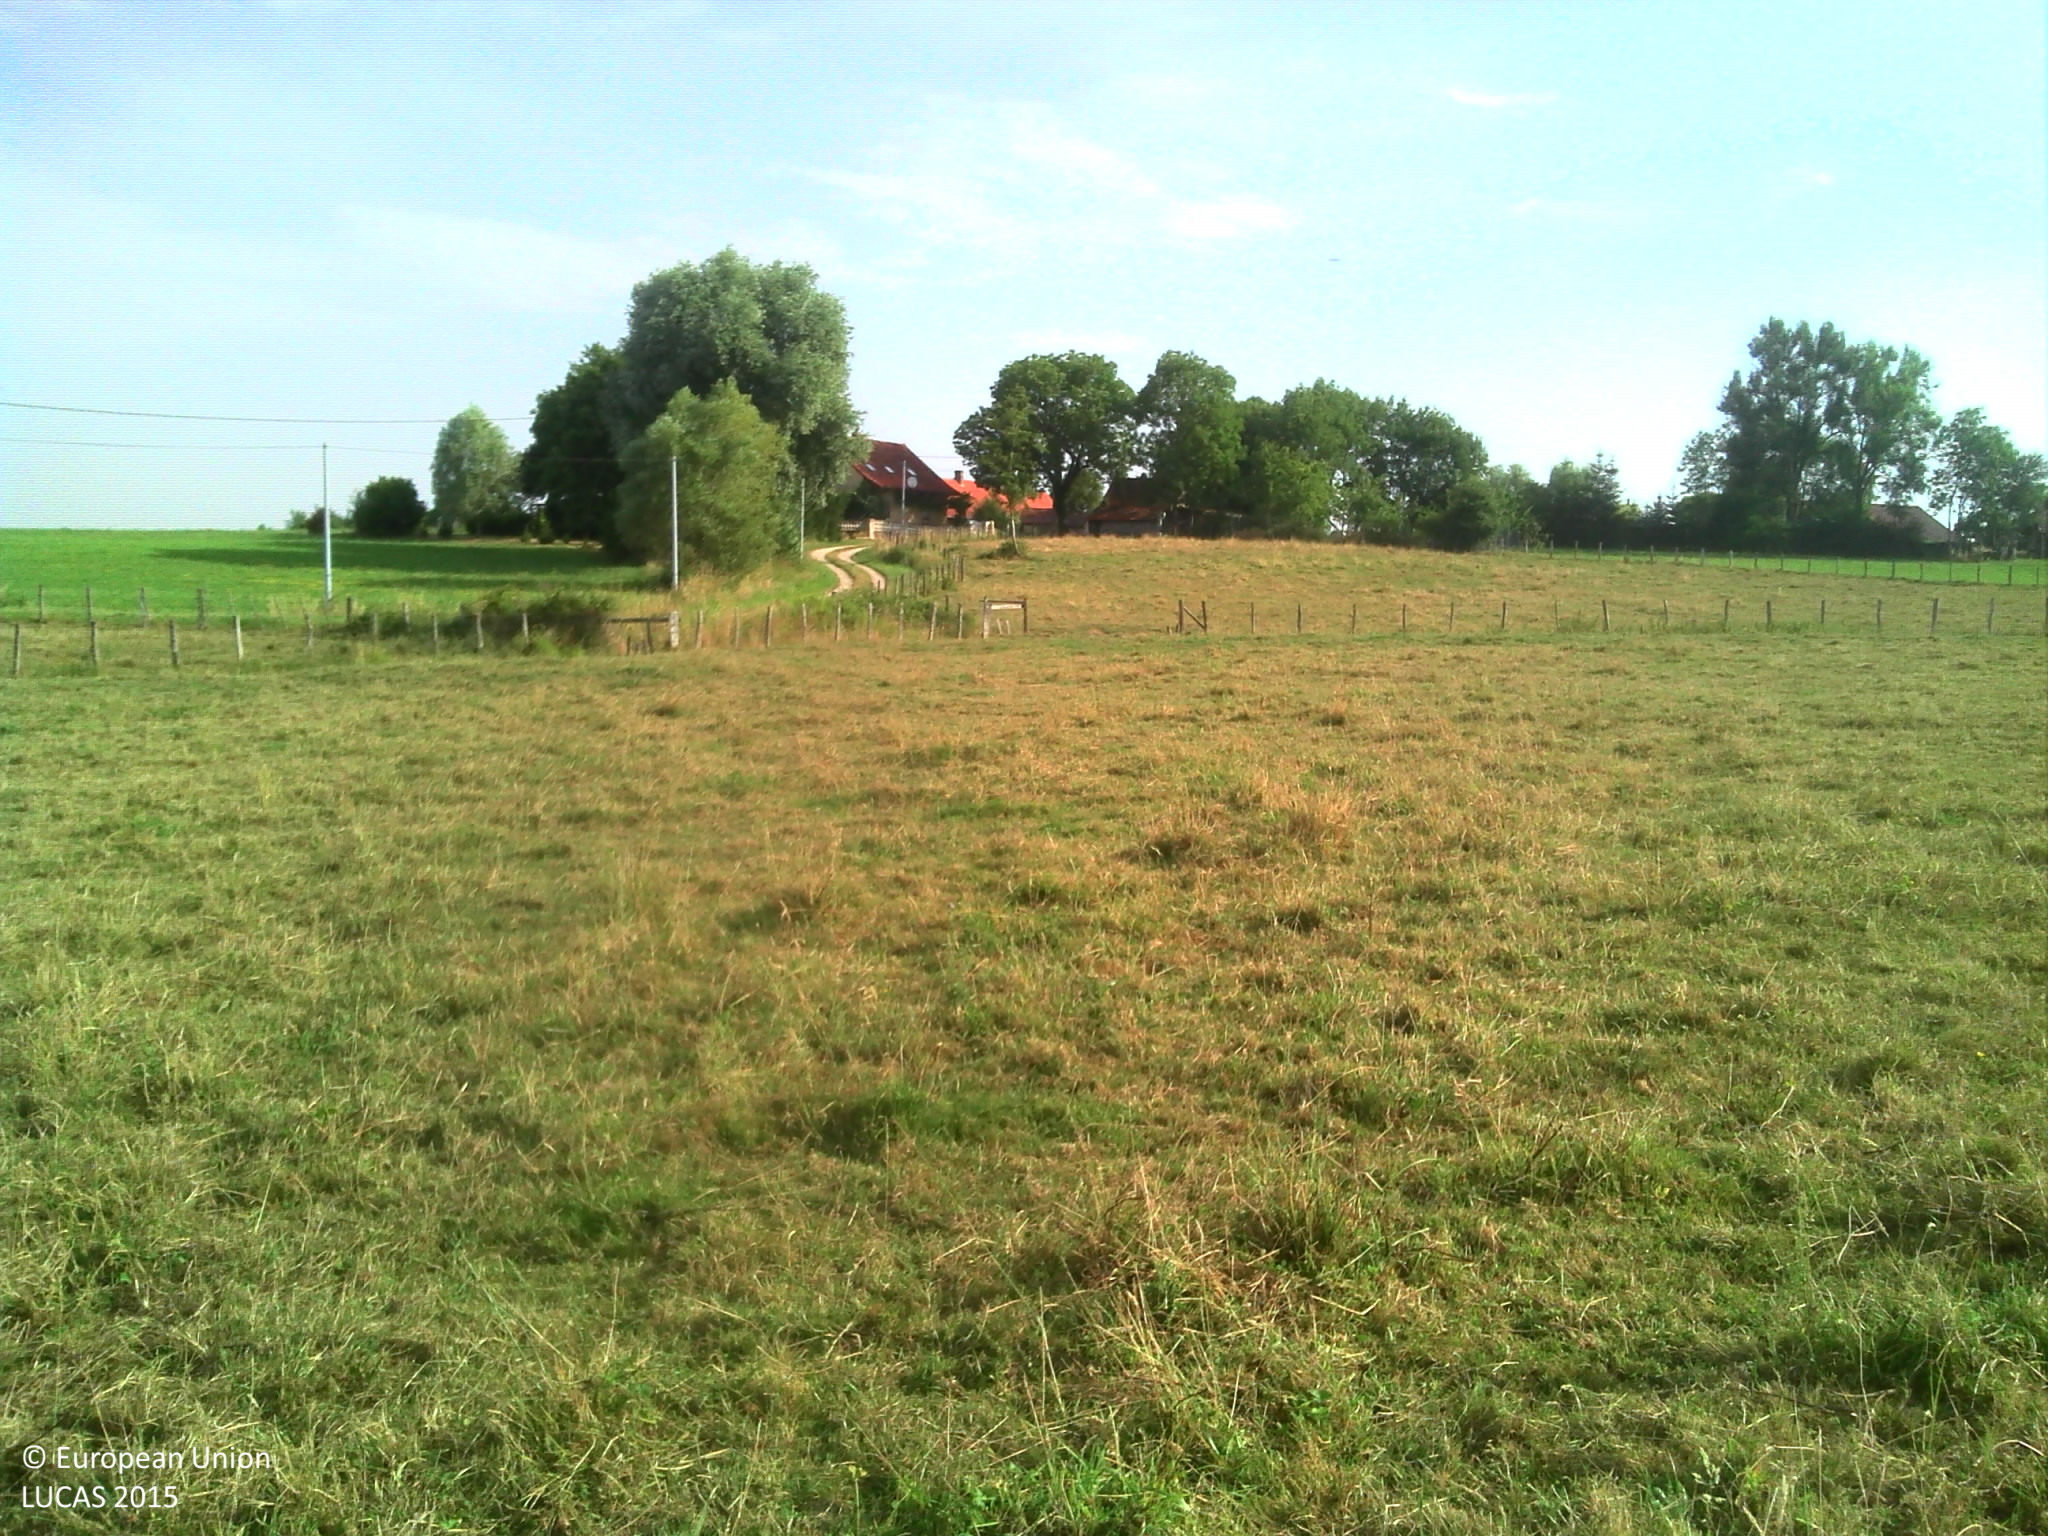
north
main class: Grassland
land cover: Grassland without tree/shrub cover
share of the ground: > 75 %
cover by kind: herbaceous plants 100 %
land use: Agriculture (excluding fallow land and kitchen gardens)
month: July
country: FR
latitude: 46.8475
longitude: 5.3989
